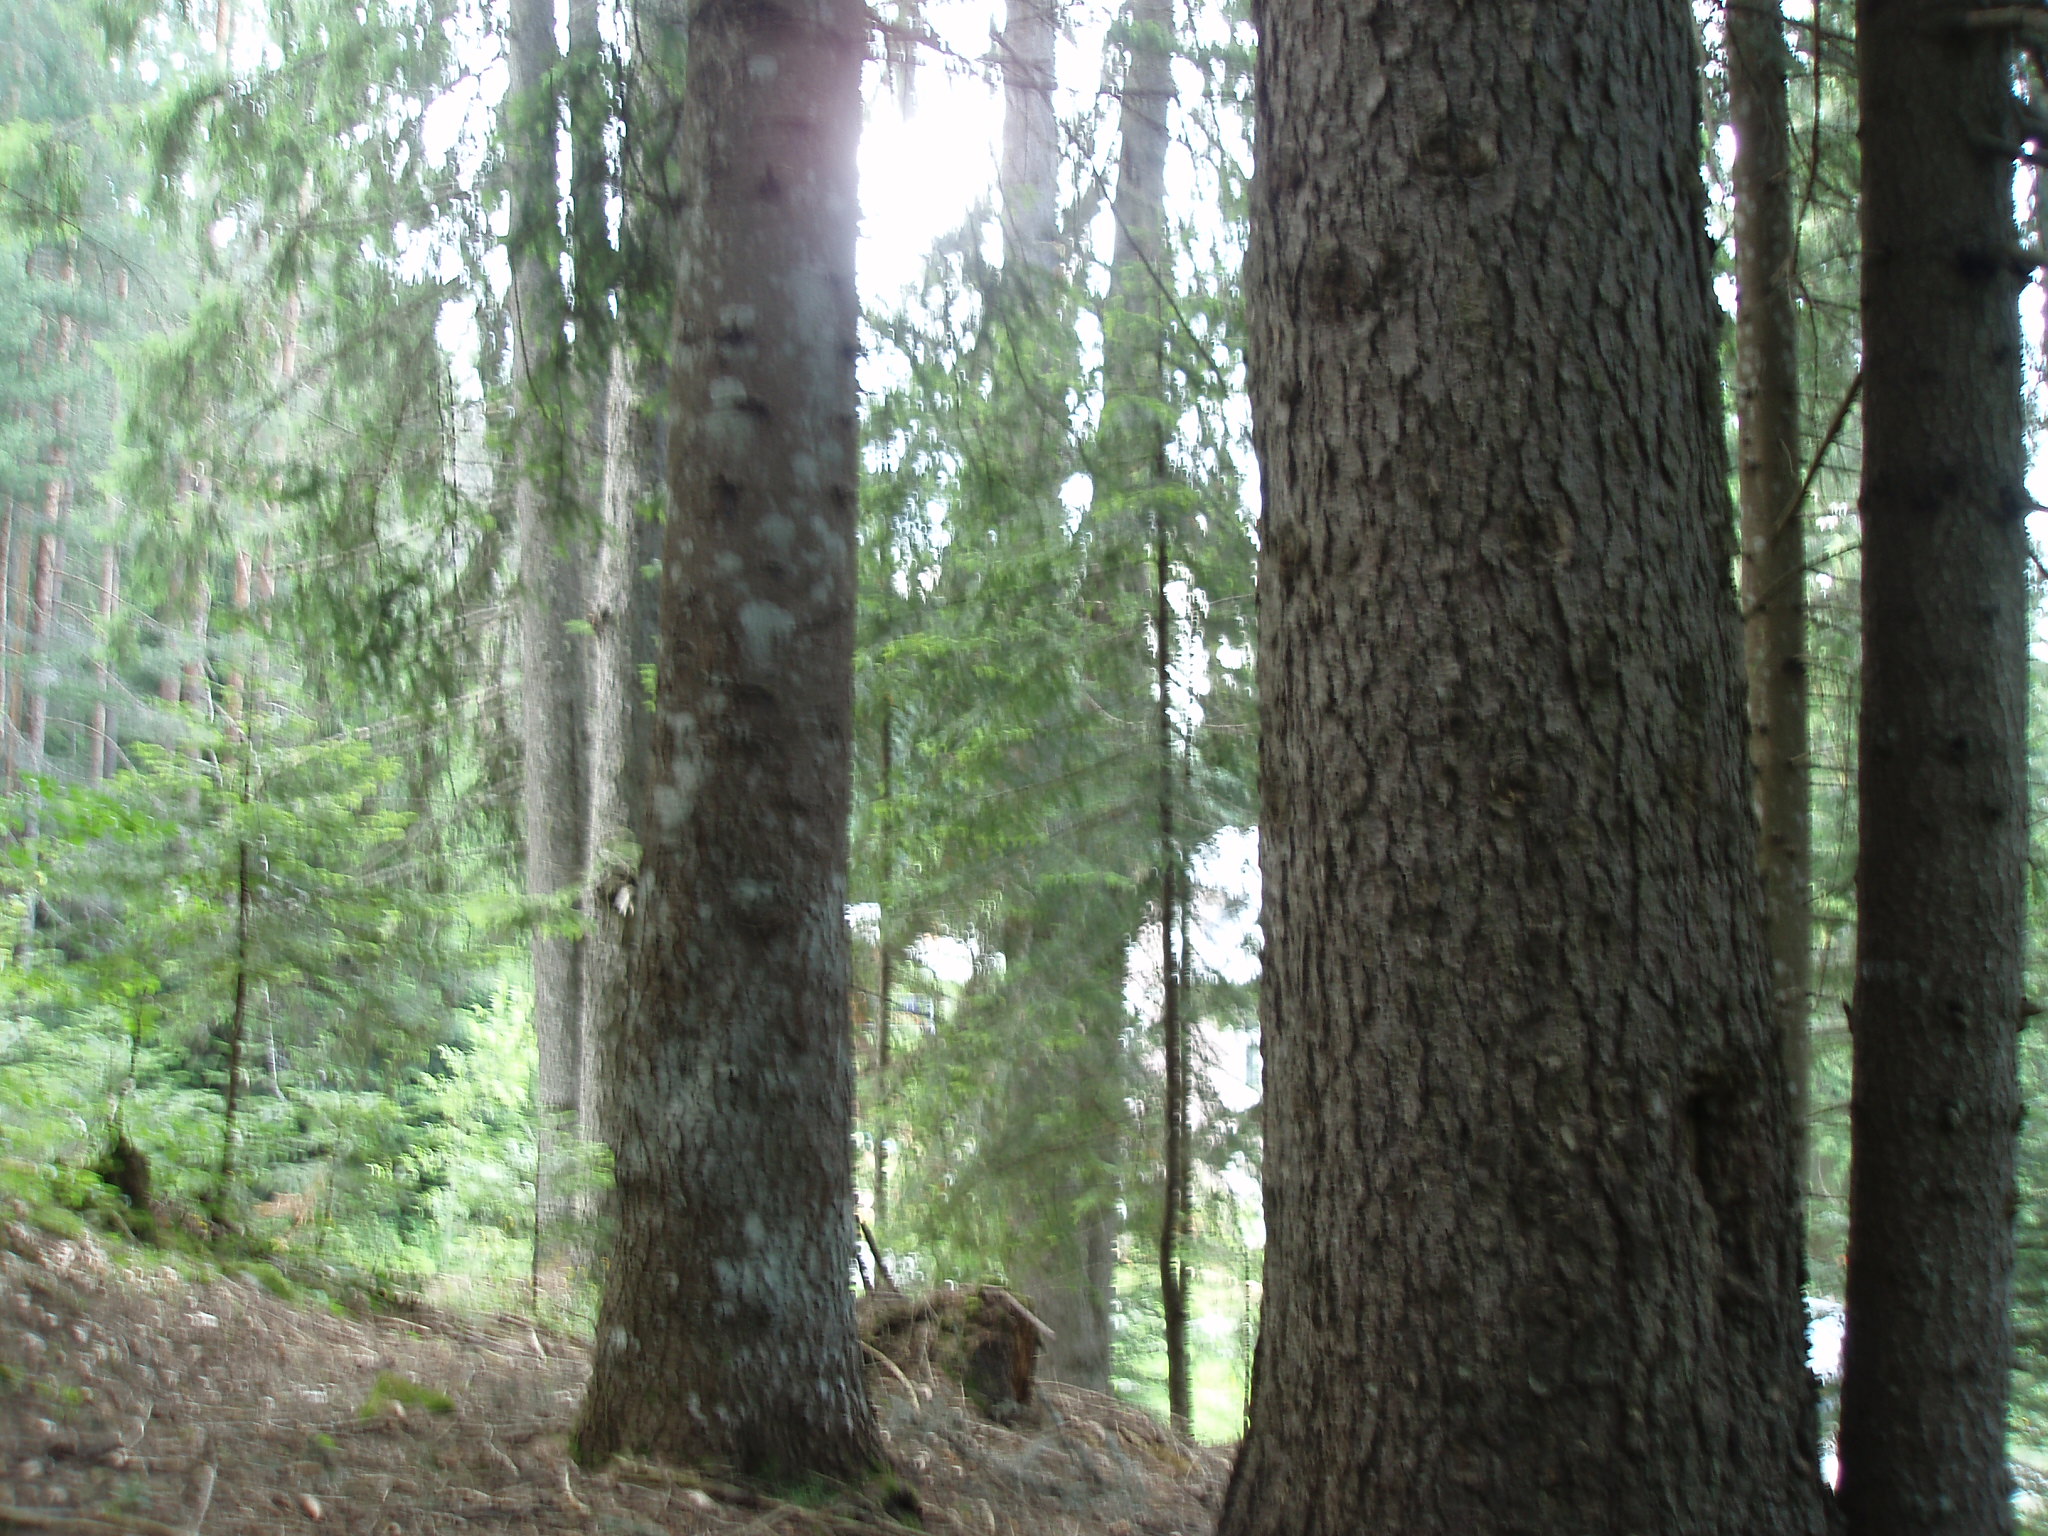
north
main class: Woodland
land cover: Spruce dominated mixed woodland
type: hemiboreal forest and nemoral coniferous forest and mixed broadleaved-coniferous forest
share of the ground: > 75 %
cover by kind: coniferous forest trees 75 %, broadleaved forest trees 25 %
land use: Amenities, museums, leisure
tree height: > 5 m
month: July
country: BG
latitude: 41.8043
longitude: 23.4713
